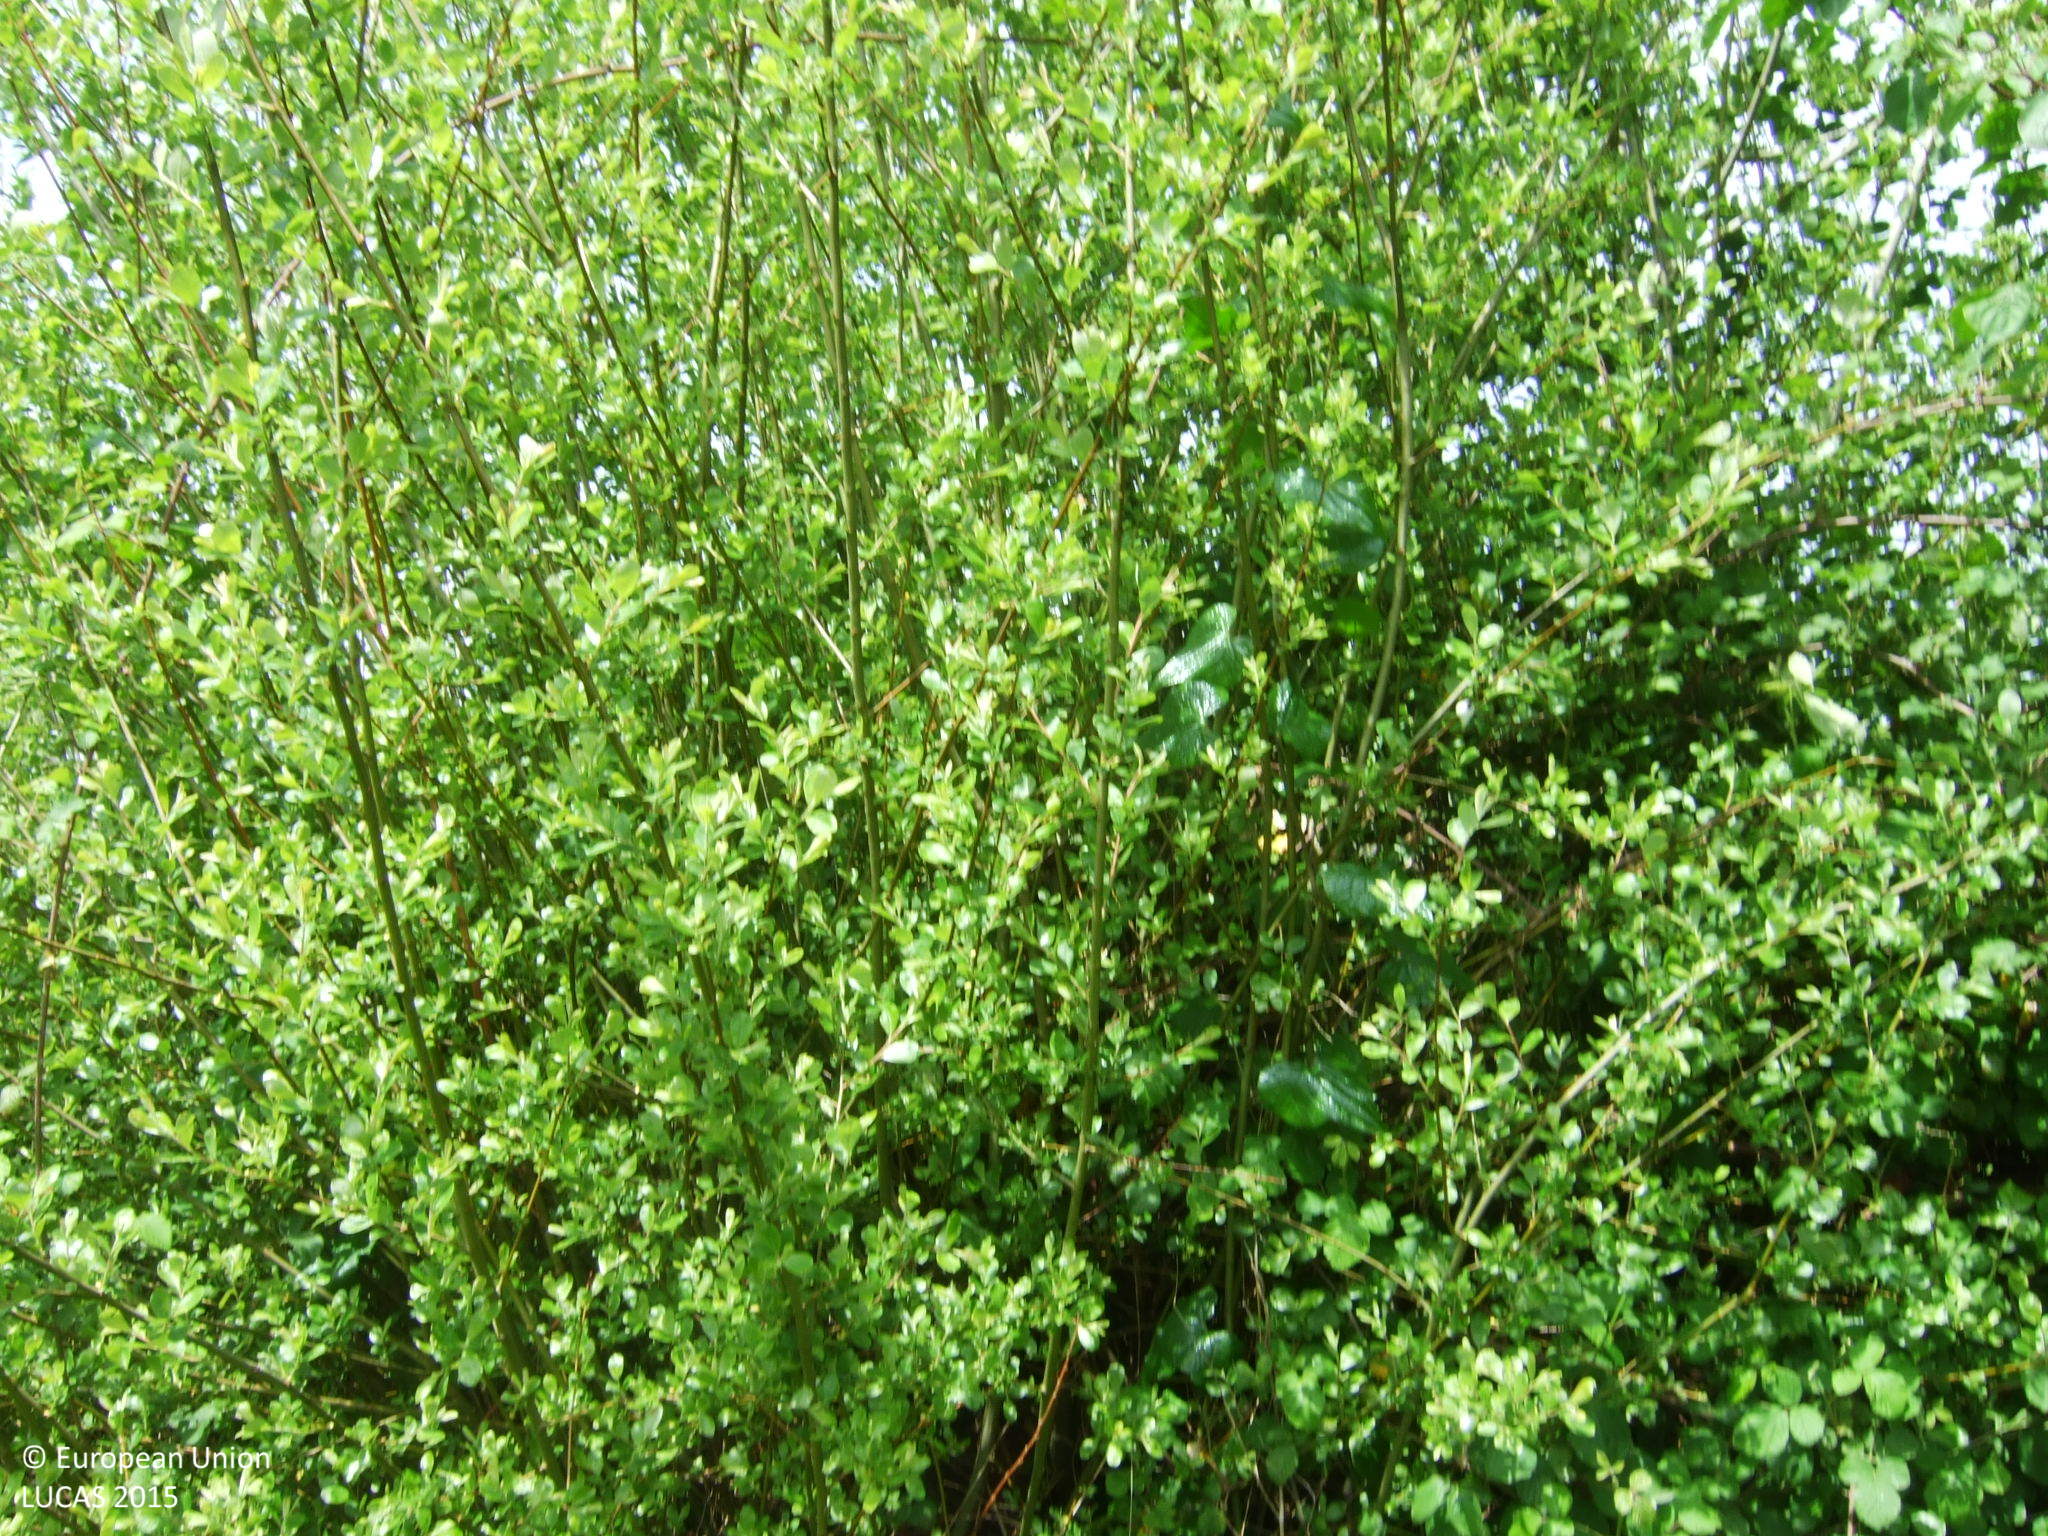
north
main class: Grassland
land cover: Grassland without tree/shrub cover
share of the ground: > 75 %
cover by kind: herbaceous plants 100 %
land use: Agriculture (excluding fallow land and kitchen gardens)
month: May
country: ES
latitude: 42.8372
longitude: -7.3569
